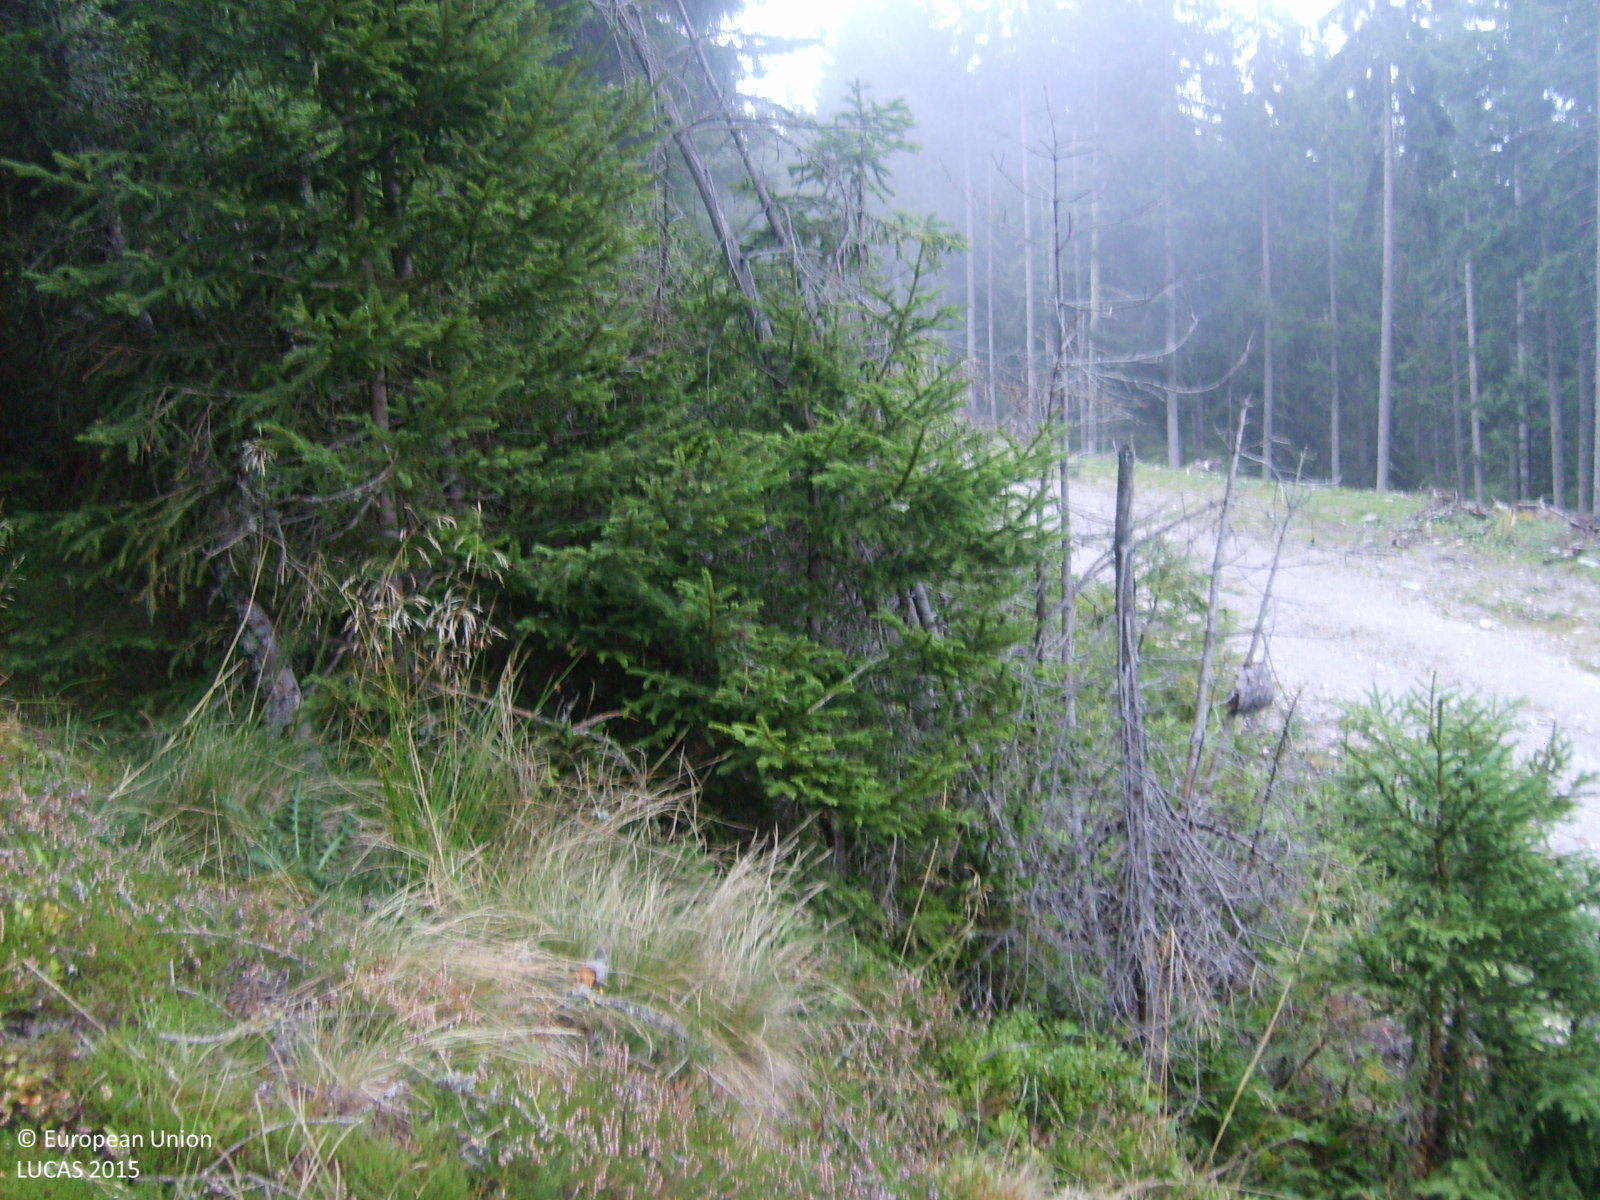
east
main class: Woodland
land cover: Spruce dominated coniferous woodland
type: alpine coniferous forest
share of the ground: > 75 %
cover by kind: coniferous forest trees 85 %, shrubs 10 %, herbaceous plants 5 %
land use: Forestry
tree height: > 5 m
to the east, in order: Spruce dominated coniferous woodland; Ditches and canals; Tracks; Spruce dominated coniferous woodland; Tracks; Fences; Rivers and streams; Spruce dominated coniferous woodland; Tracks
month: September
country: AT
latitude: 47.4111
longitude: 13.5103
